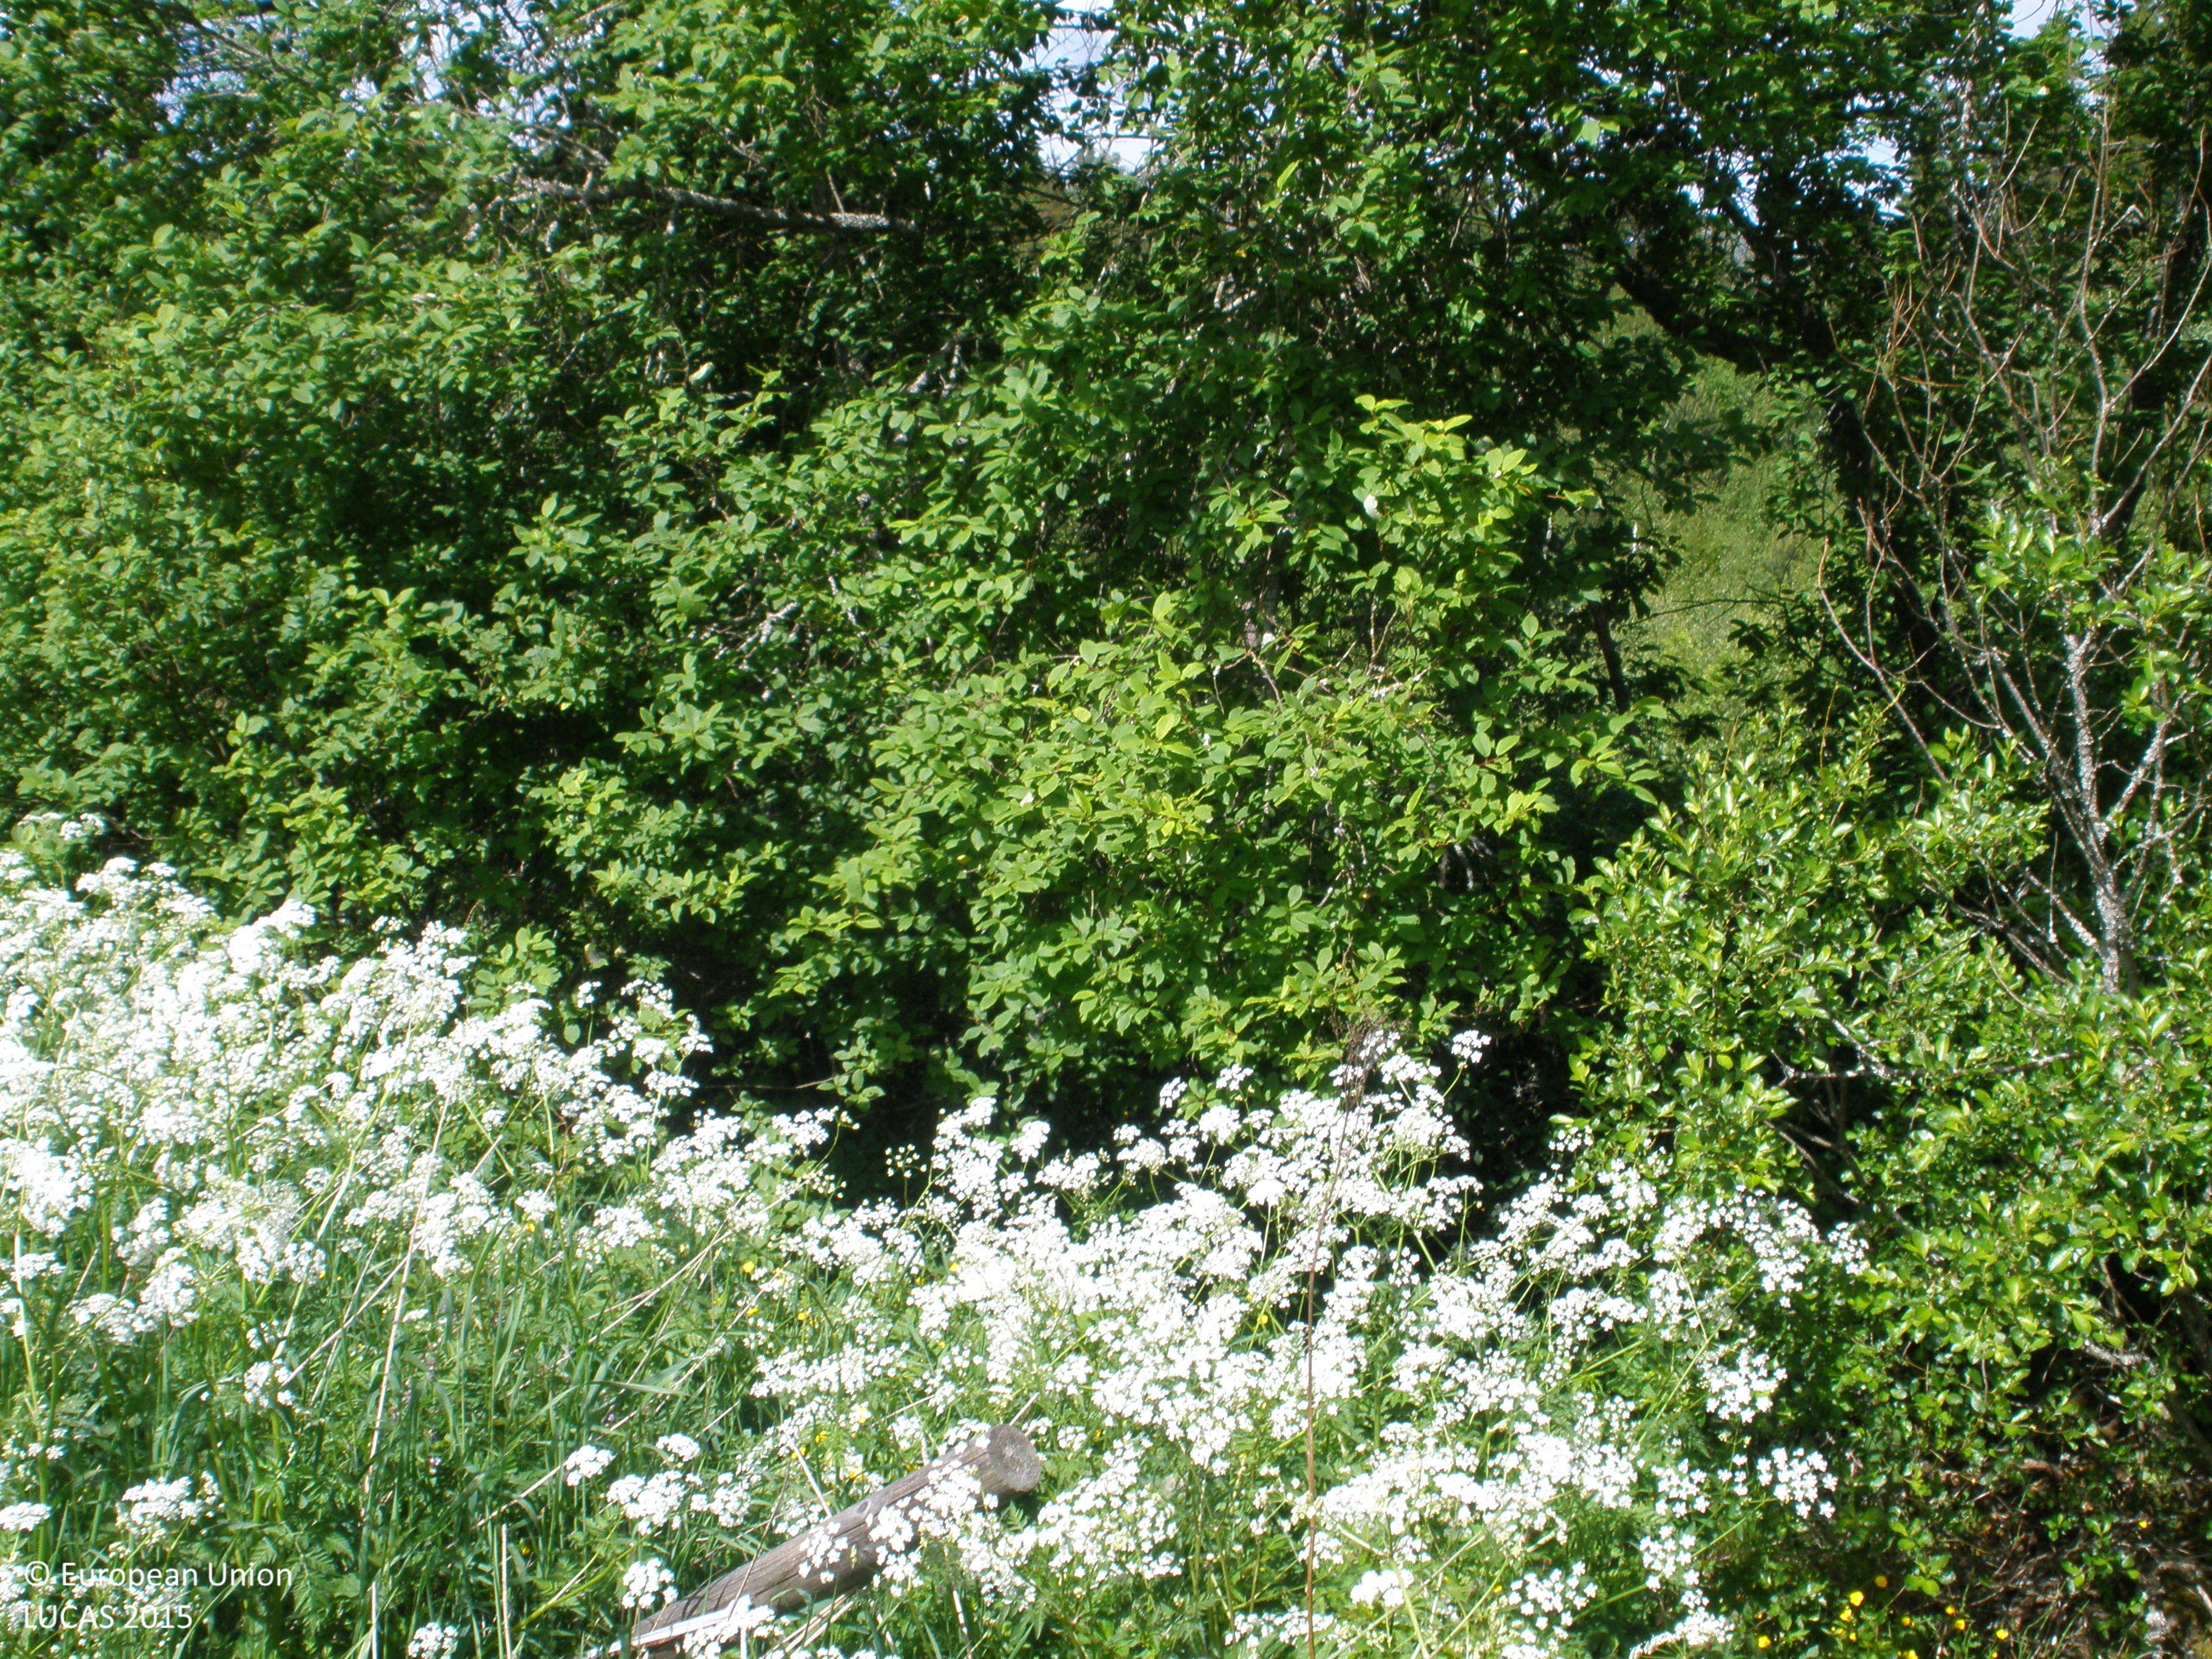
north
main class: Woodland
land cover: Broadleaved woodland
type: non-riverine alder, birch or aspen forest
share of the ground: > 75 %
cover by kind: broadleaved forest trees 80 %, herbaceous plants 15 %, shrubs 5 %
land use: Forestry
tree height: > 5 m
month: June
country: FI
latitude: 61.1053
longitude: 24.5930
